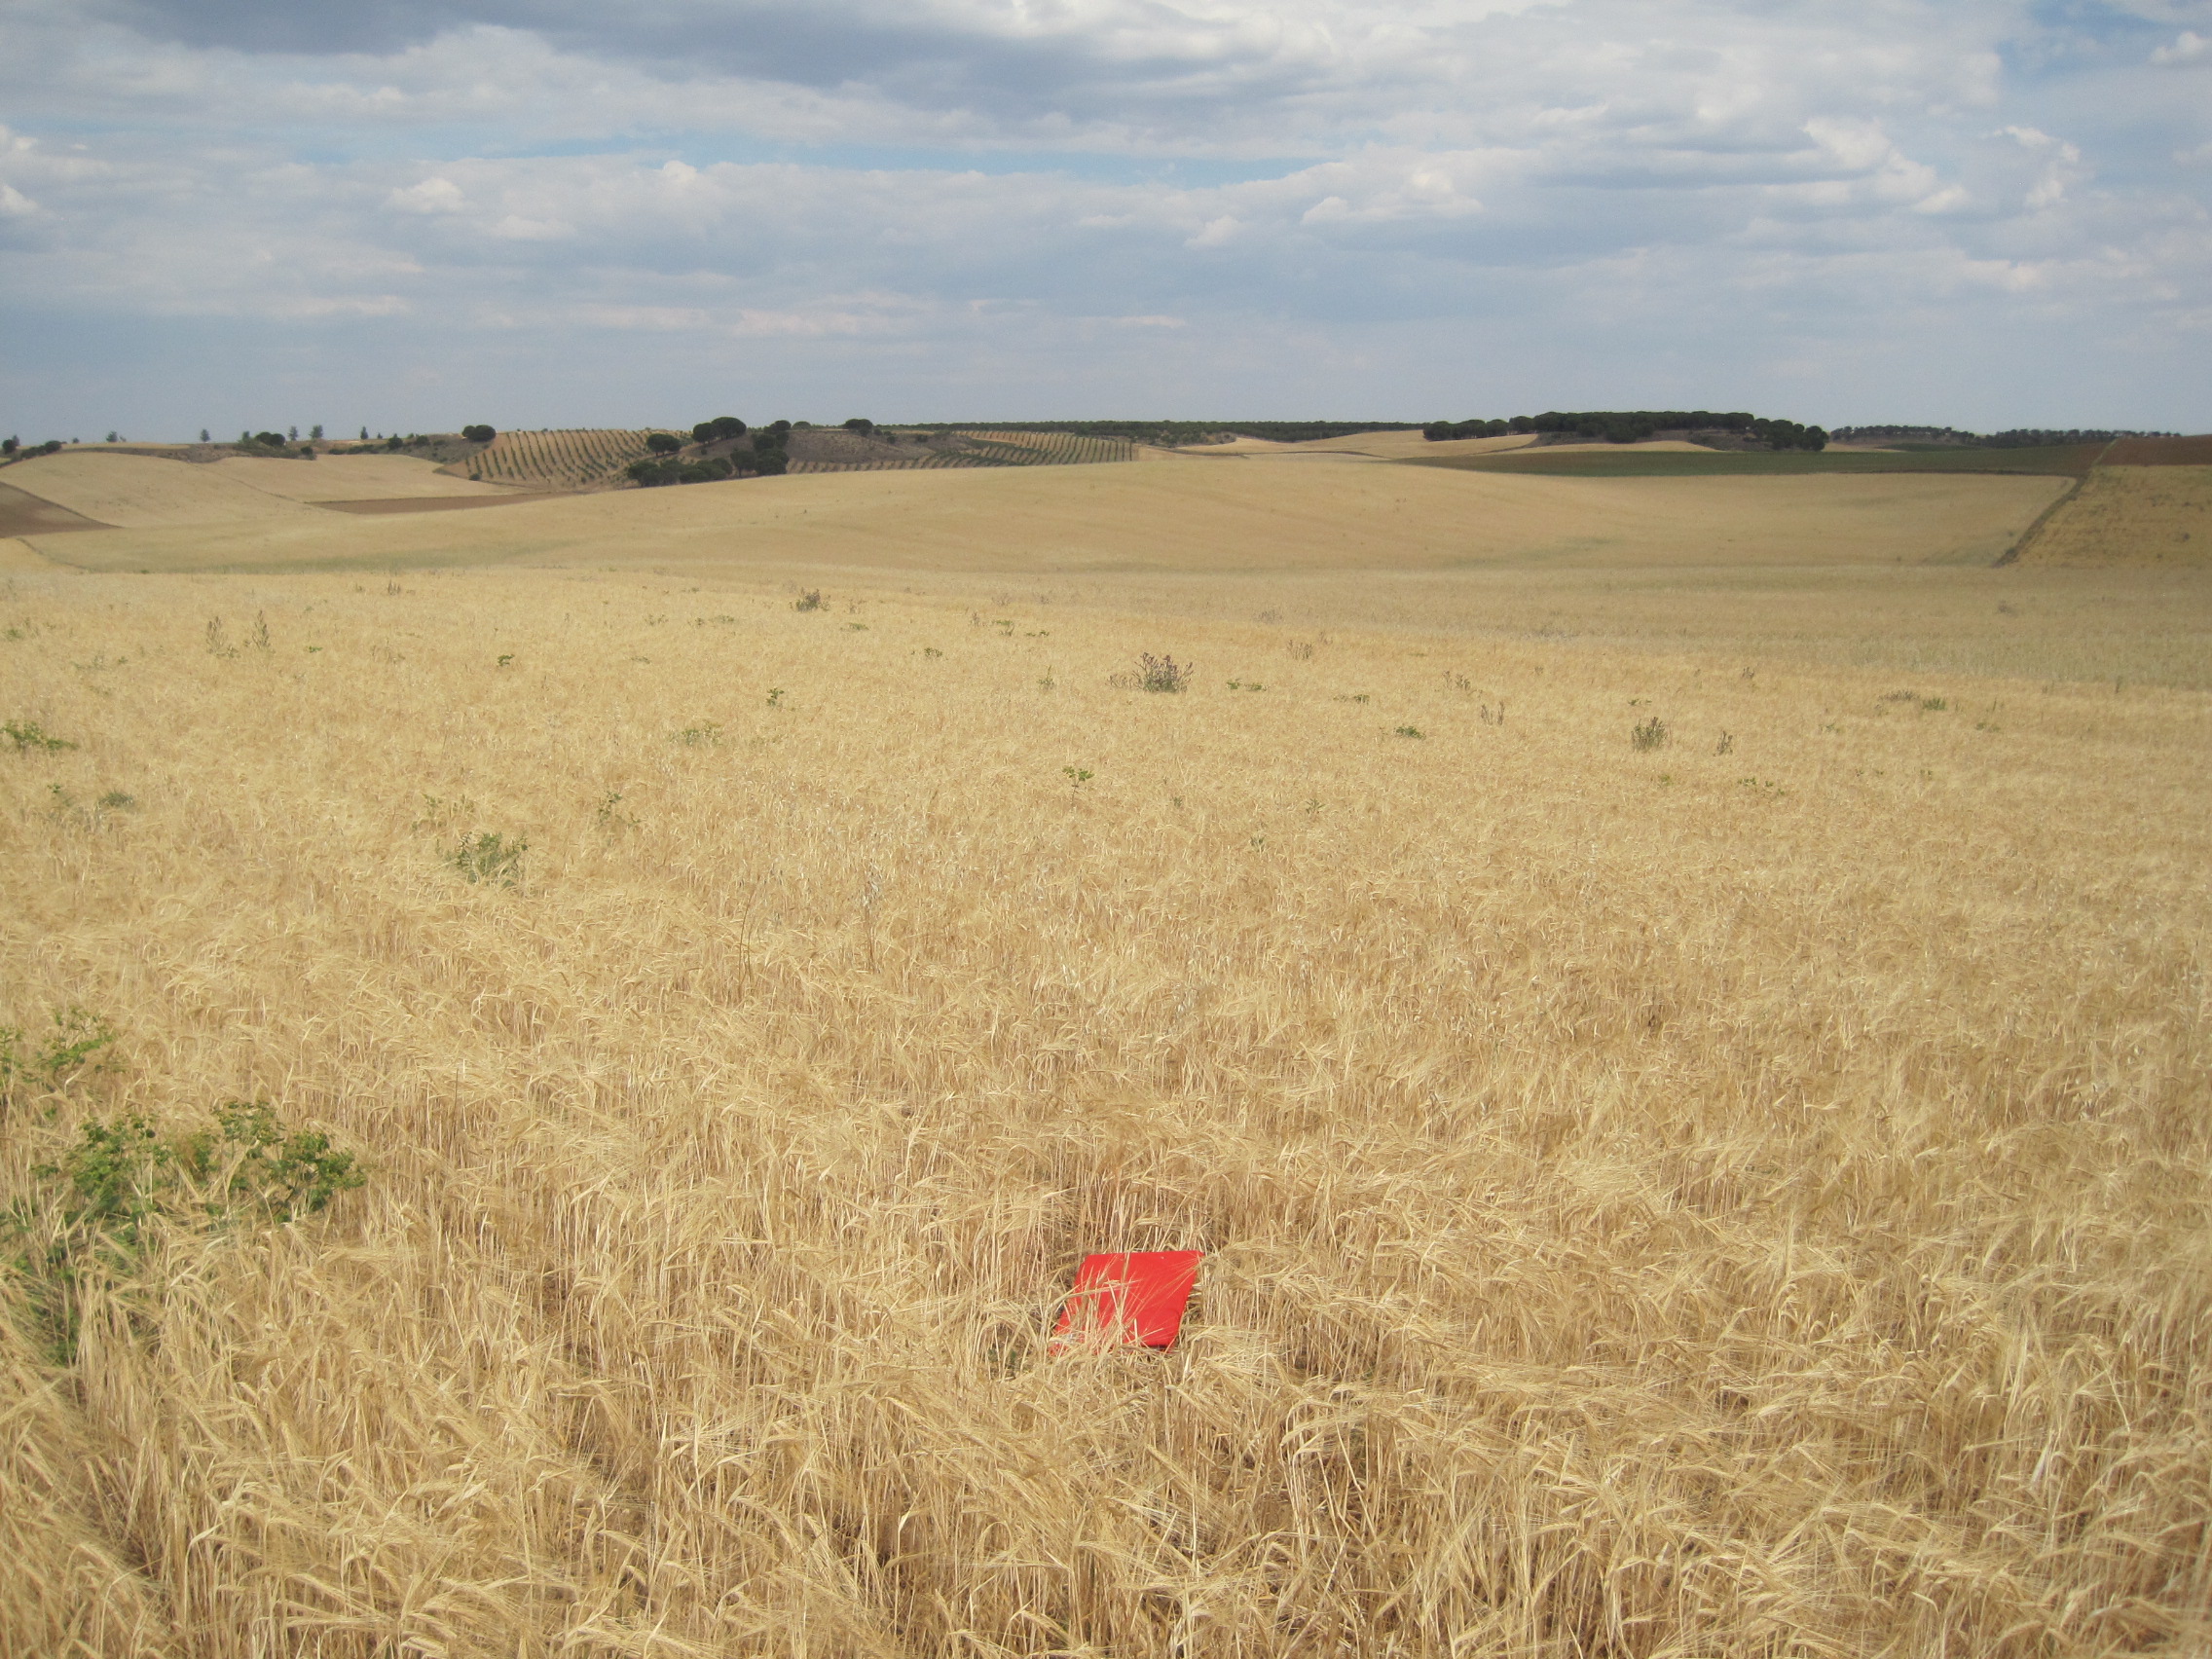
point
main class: Cropland
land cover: Barley
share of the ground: > 75 %
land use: Agriculture (excluding fallow land and kitchen gardens)
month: June
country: ES
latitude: 41.3926
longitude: -5.0572
